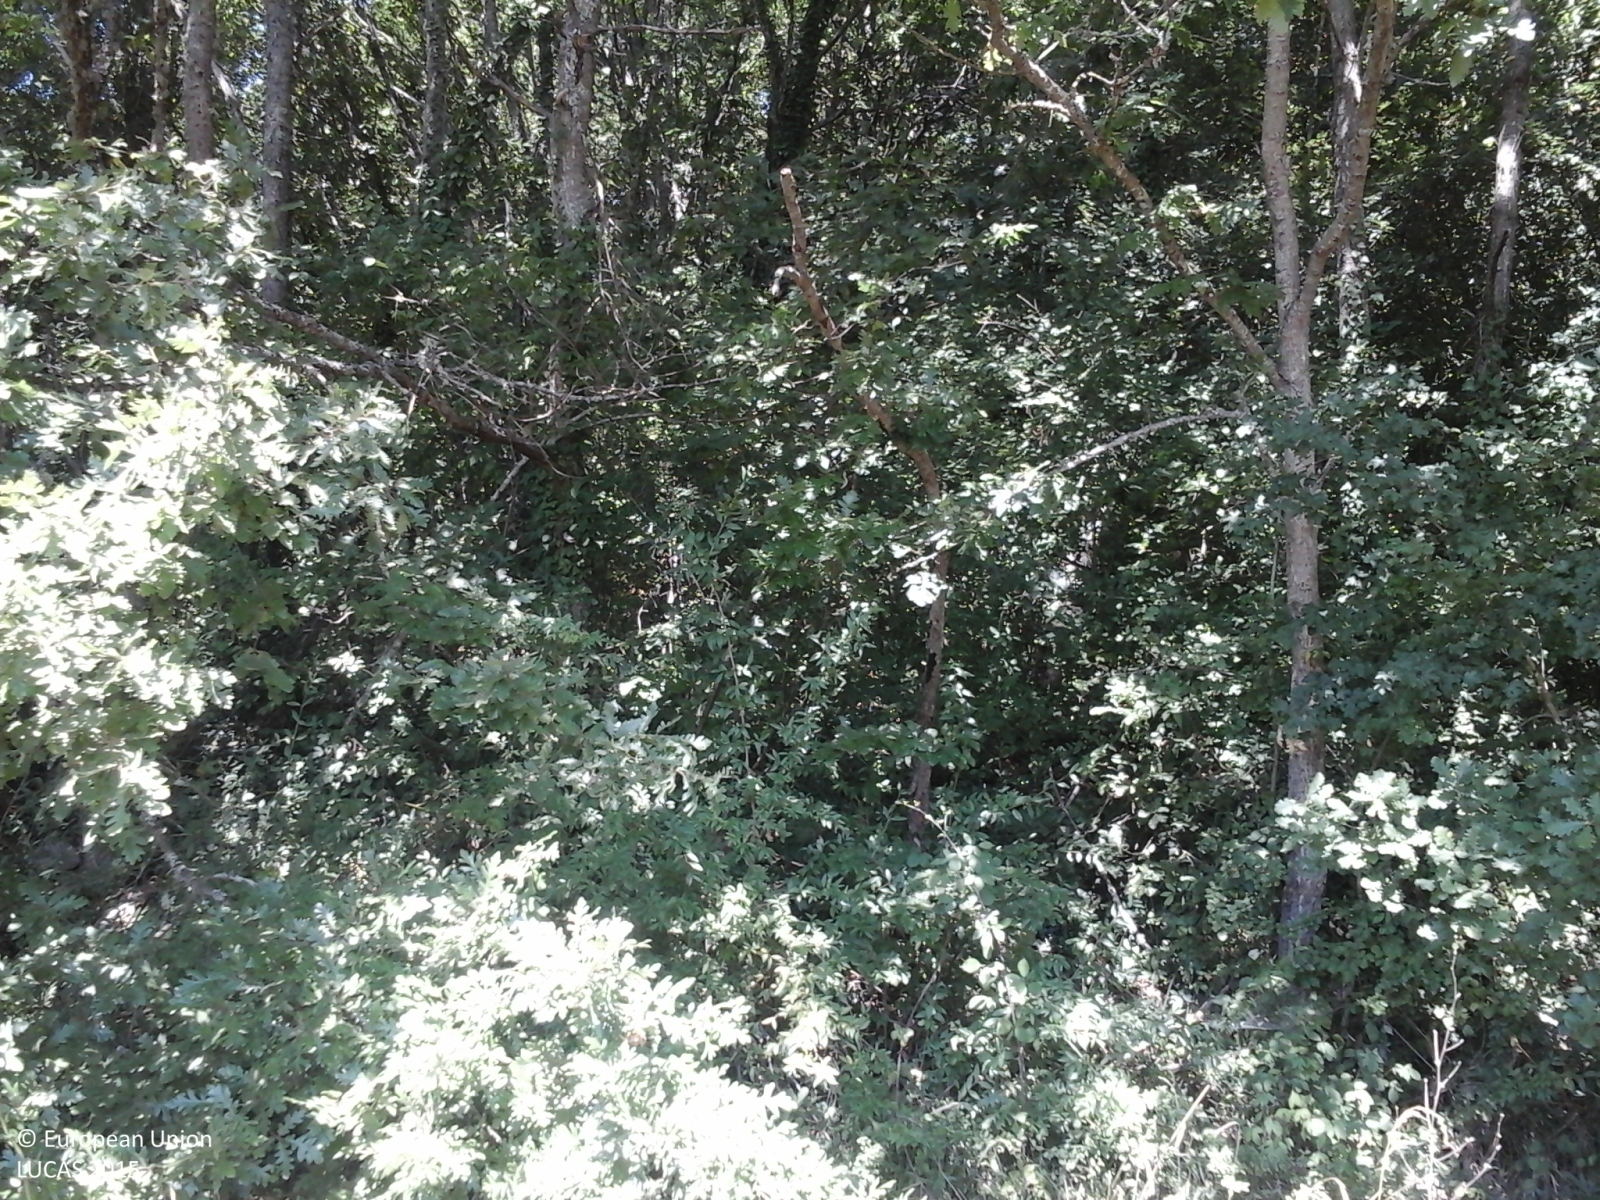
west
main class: Woodland
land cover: Broadleaved woodland
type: thermophilous deciduous forest
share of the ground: > 75 %
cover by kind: broadleaved forest trees 100 %
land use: Forestry
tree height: > 5 m
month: August
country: IT
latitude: 42.2066
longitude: 13.1747
